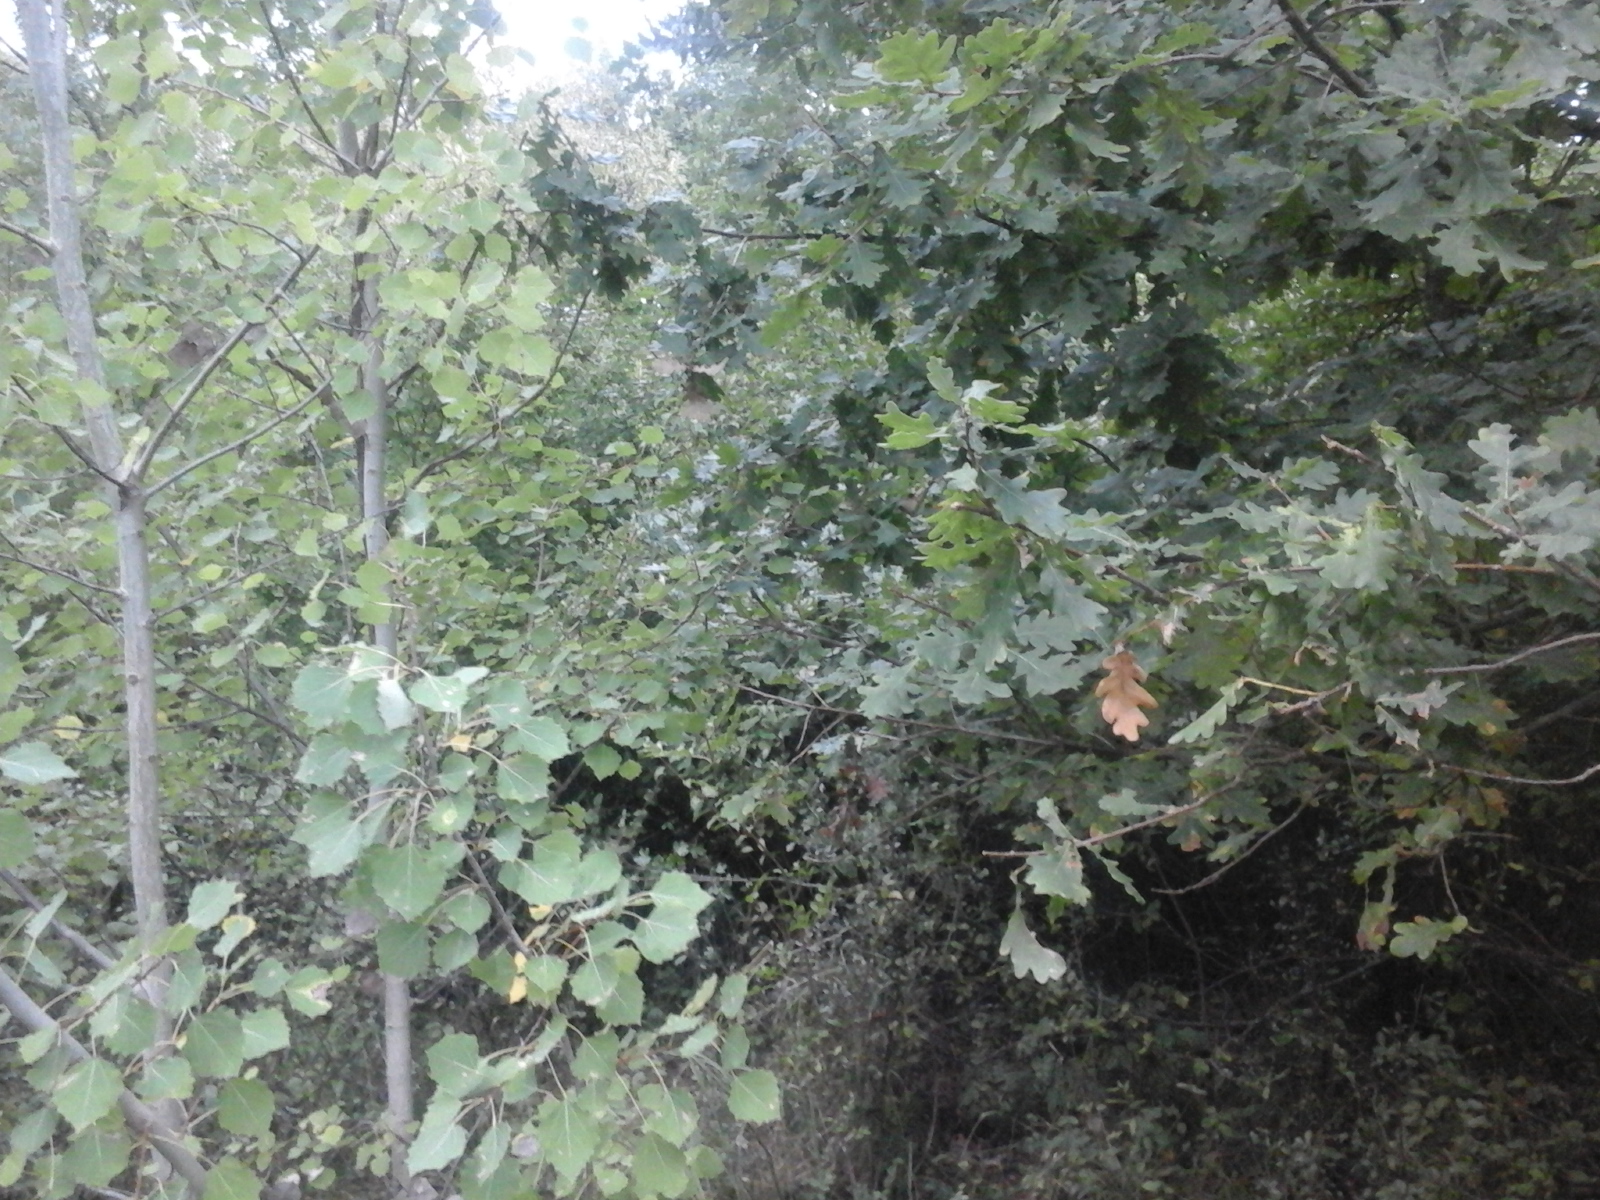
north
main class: Woodland
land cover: Broadleaved woodland
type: beech forest
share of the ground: > 75 %
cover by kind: broadleaved forest trees 100 %
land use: Forestry
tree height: > 5 m
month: August
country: RO
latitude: 45.6222
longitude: 21.6417
